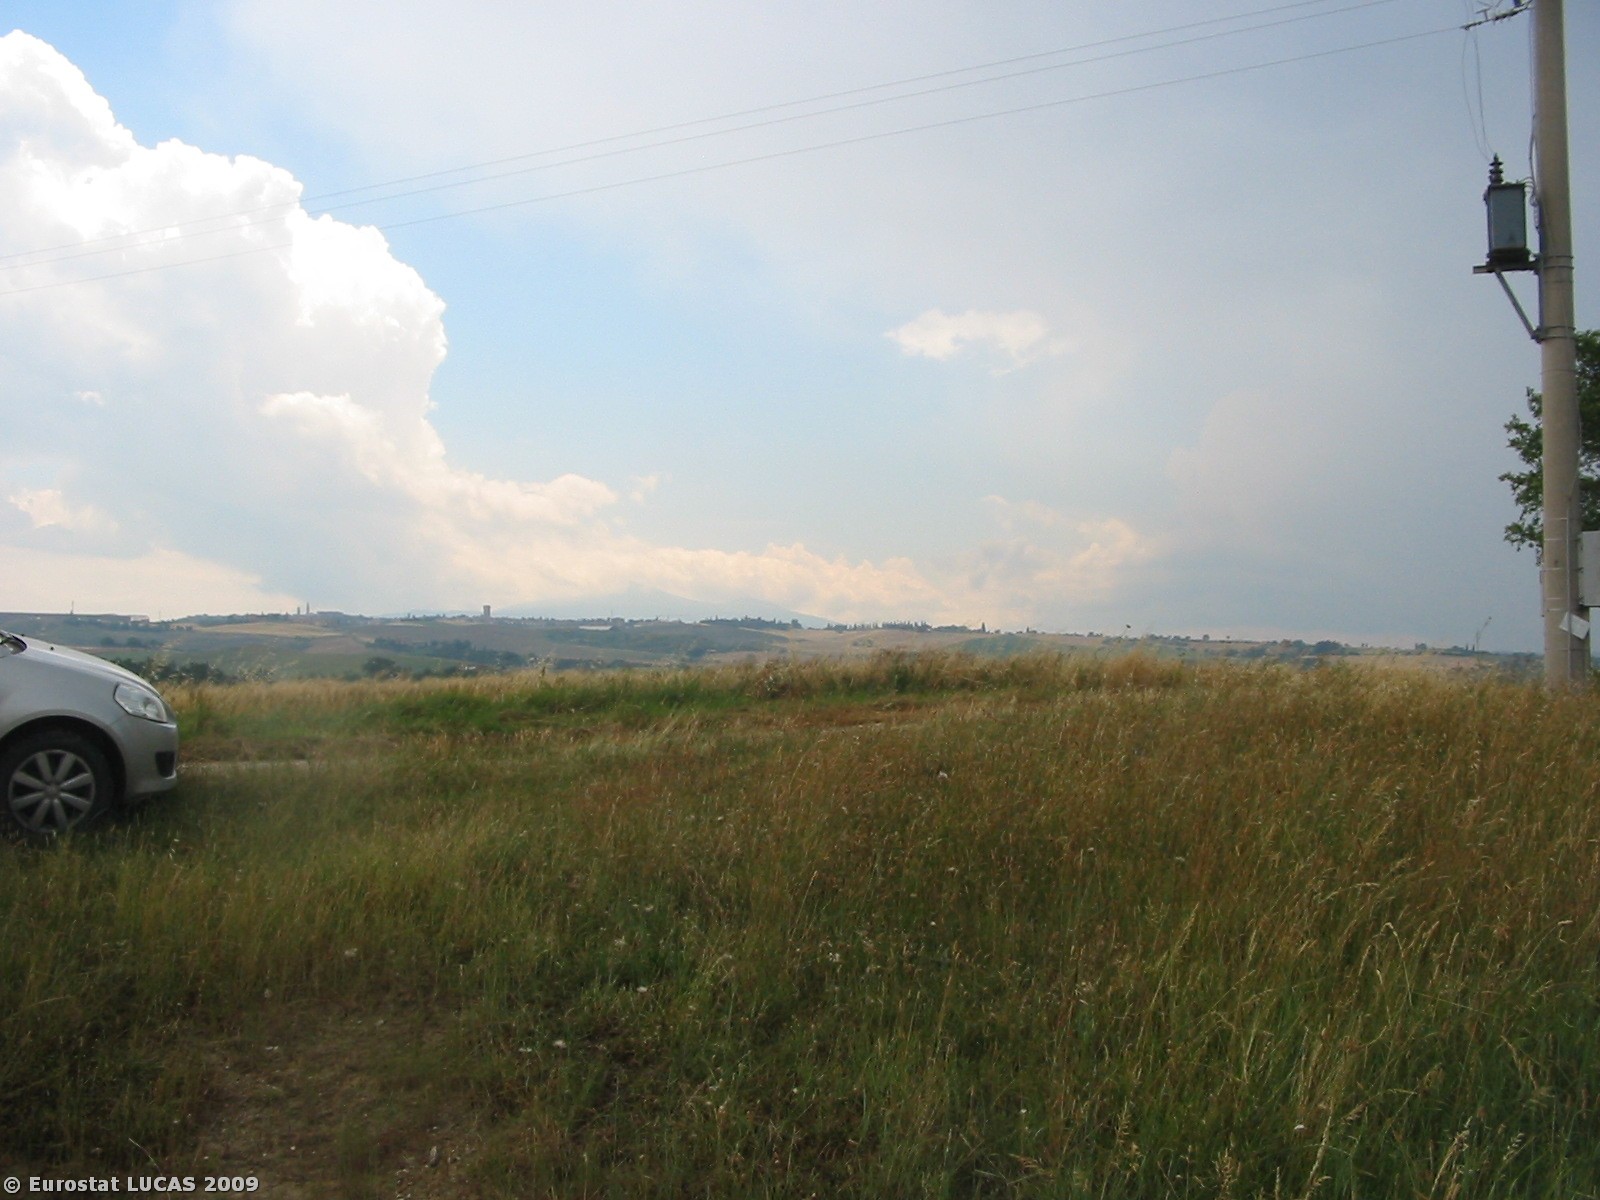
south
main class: Cropland
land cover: Durum wheat
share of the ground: > 75 %
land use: Agriculture (excluding fallow land and kitchen gardens)
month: June
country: IT
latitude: 43.1097
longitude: 11.6785
